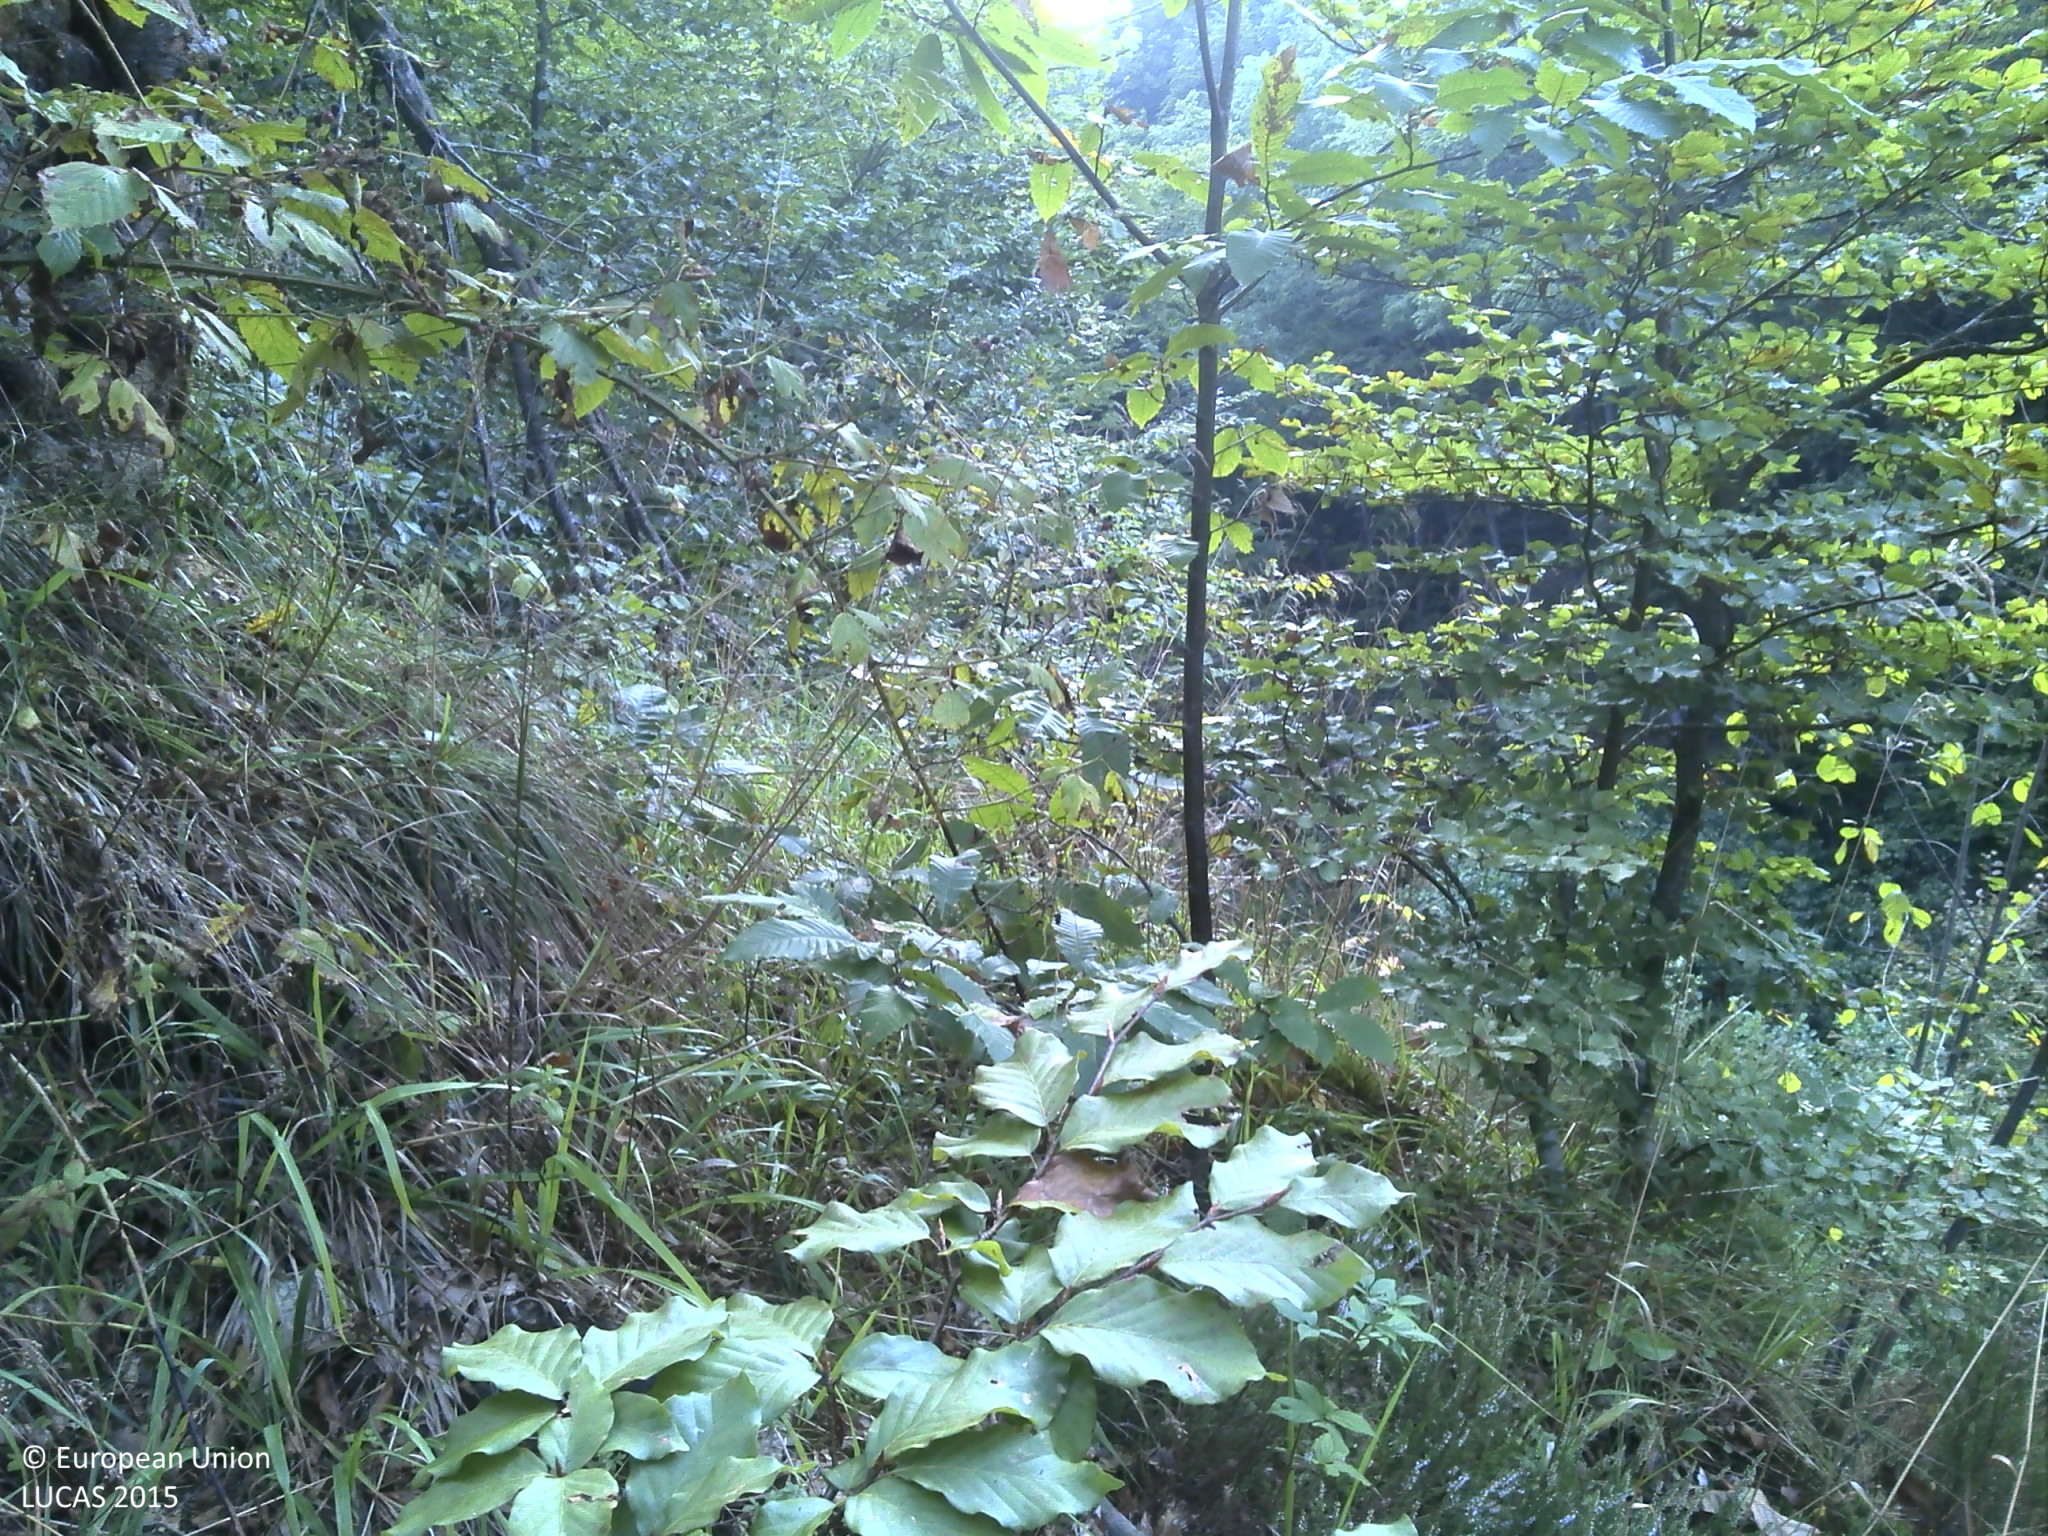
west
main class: Woodland
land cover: Broadleaved woodland
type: acidophilous oak and oak-birch forest
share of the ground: 25 - 50 %
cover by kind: herbaceous plants 45 %, broadleaved forest trees 30 %, shrubs 25 %
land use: Forestry
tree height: > 5 m
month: August
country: HR
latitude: 45.2781
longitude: 16.3327
